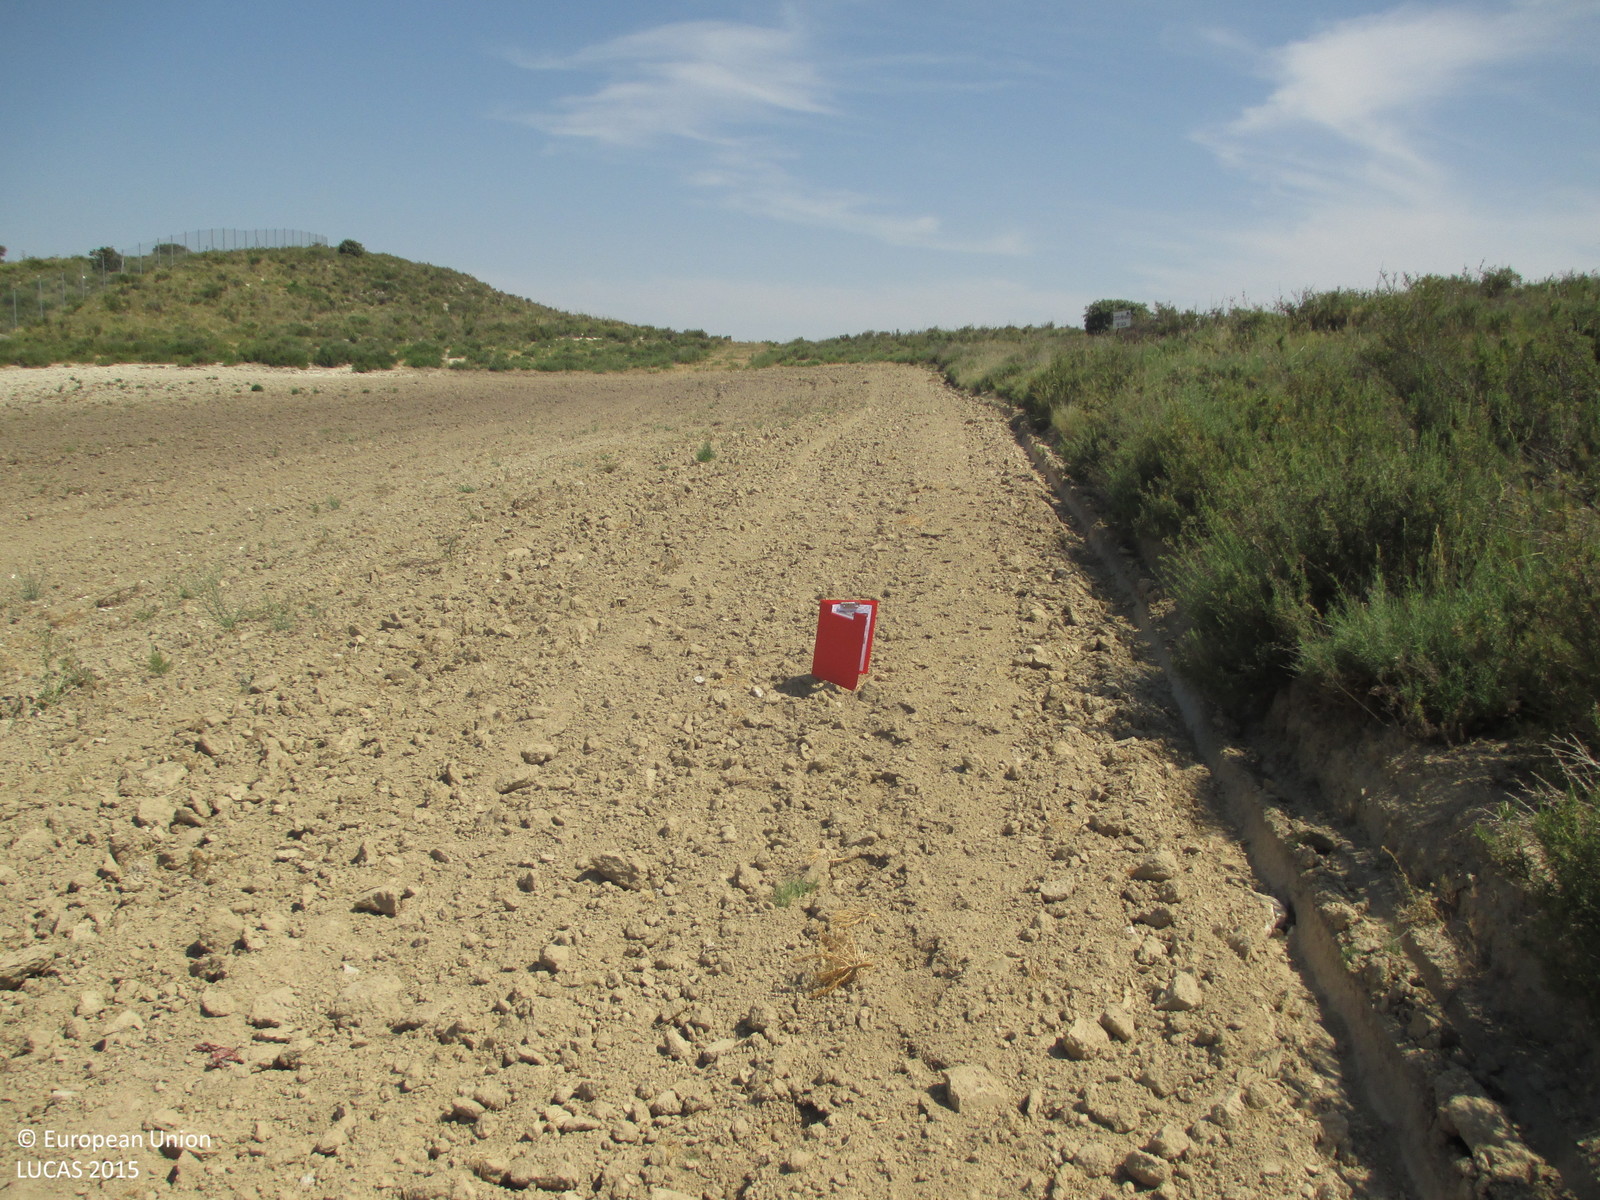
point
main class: Cropland
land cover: Sunflower
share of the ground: < 10 %
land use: Agriculture (excluding fallow land and kitchen gardens)
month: May
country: ES
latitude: 42.0167
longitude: 0.0429
